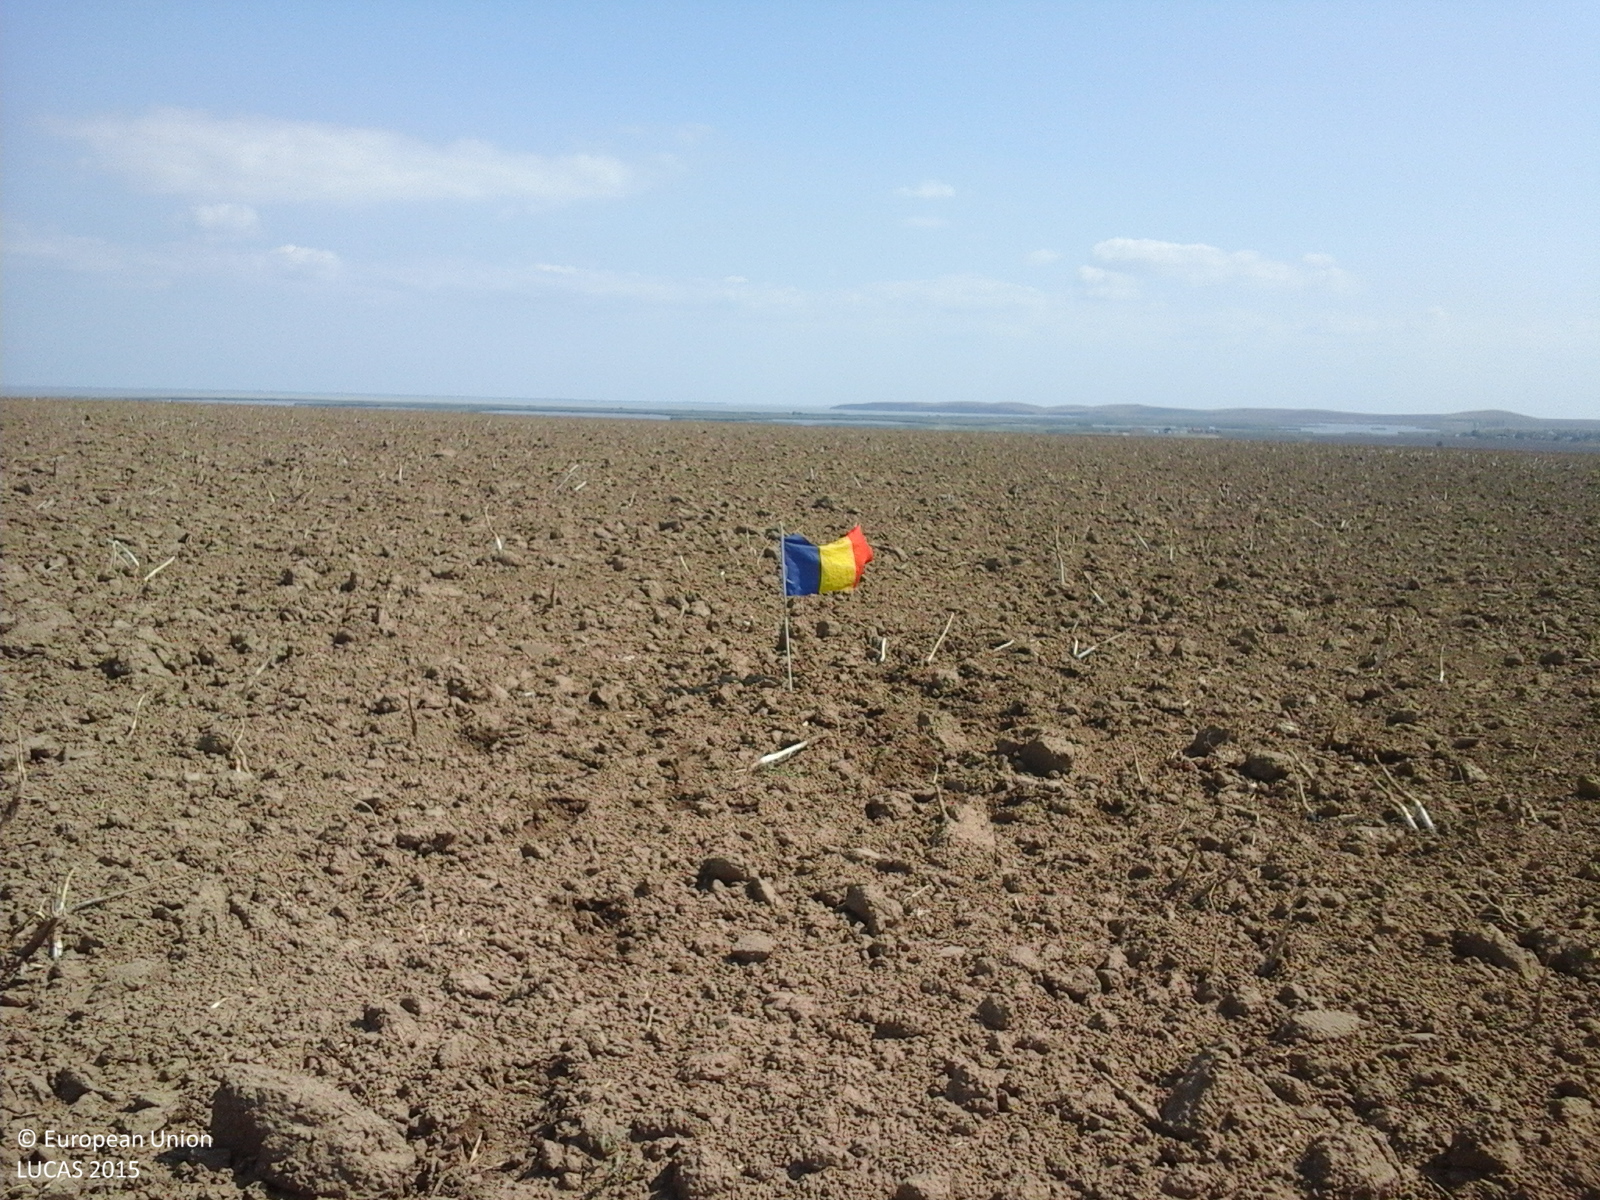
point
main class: Cropland
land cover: Rape and turnip rape
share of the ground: < 10 %
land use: Agriculture (excluding fallow land and kitchen gardens)
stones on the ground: < 10 %
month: August
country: RO
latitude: 44.8311
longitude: 28.8986
